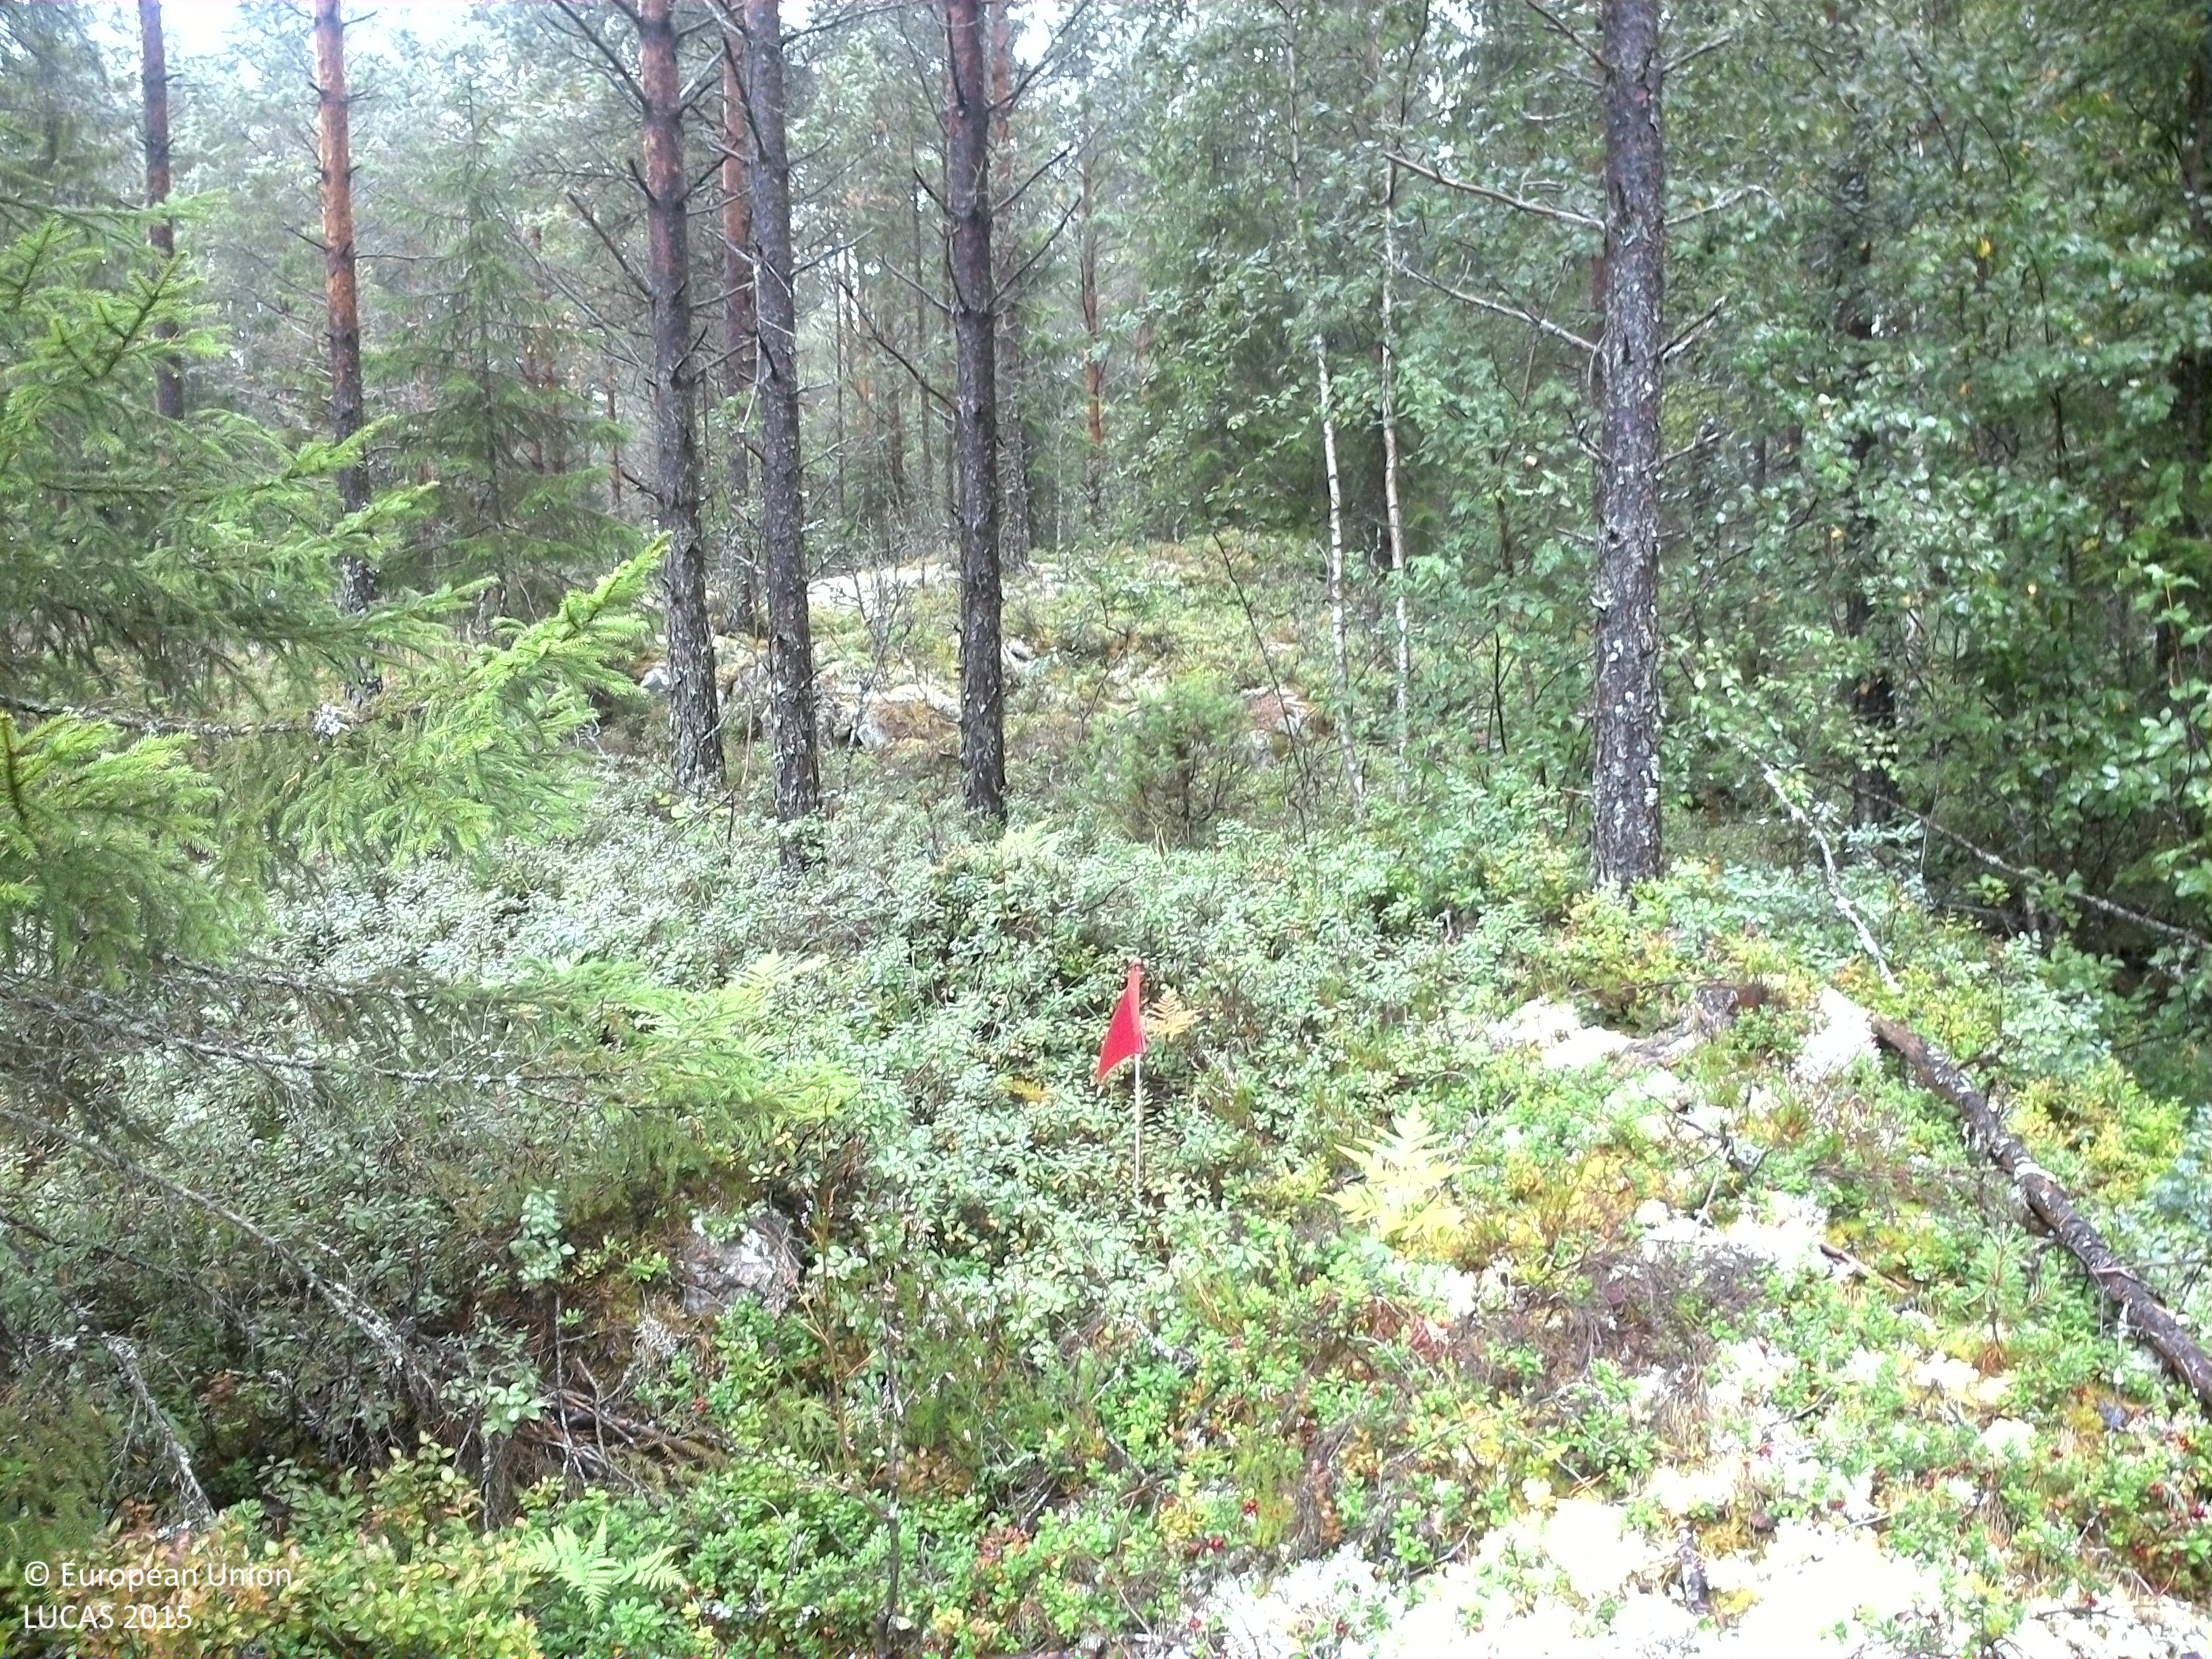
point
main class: Woodland
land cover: Pine dominated mixed woodland
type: boreal forest
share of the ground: 25 - 50 %
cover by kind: coniferous forest trees 30 %, broadleaved forest trees 20 %, shrubs 20 %, lichens and mosses 20 %, herbaceous plants 10 %
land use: Forestry
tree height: > 5 m
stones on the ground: 10 - 25 %
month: September
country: SE
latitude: 59.3375
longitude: 12.0517
